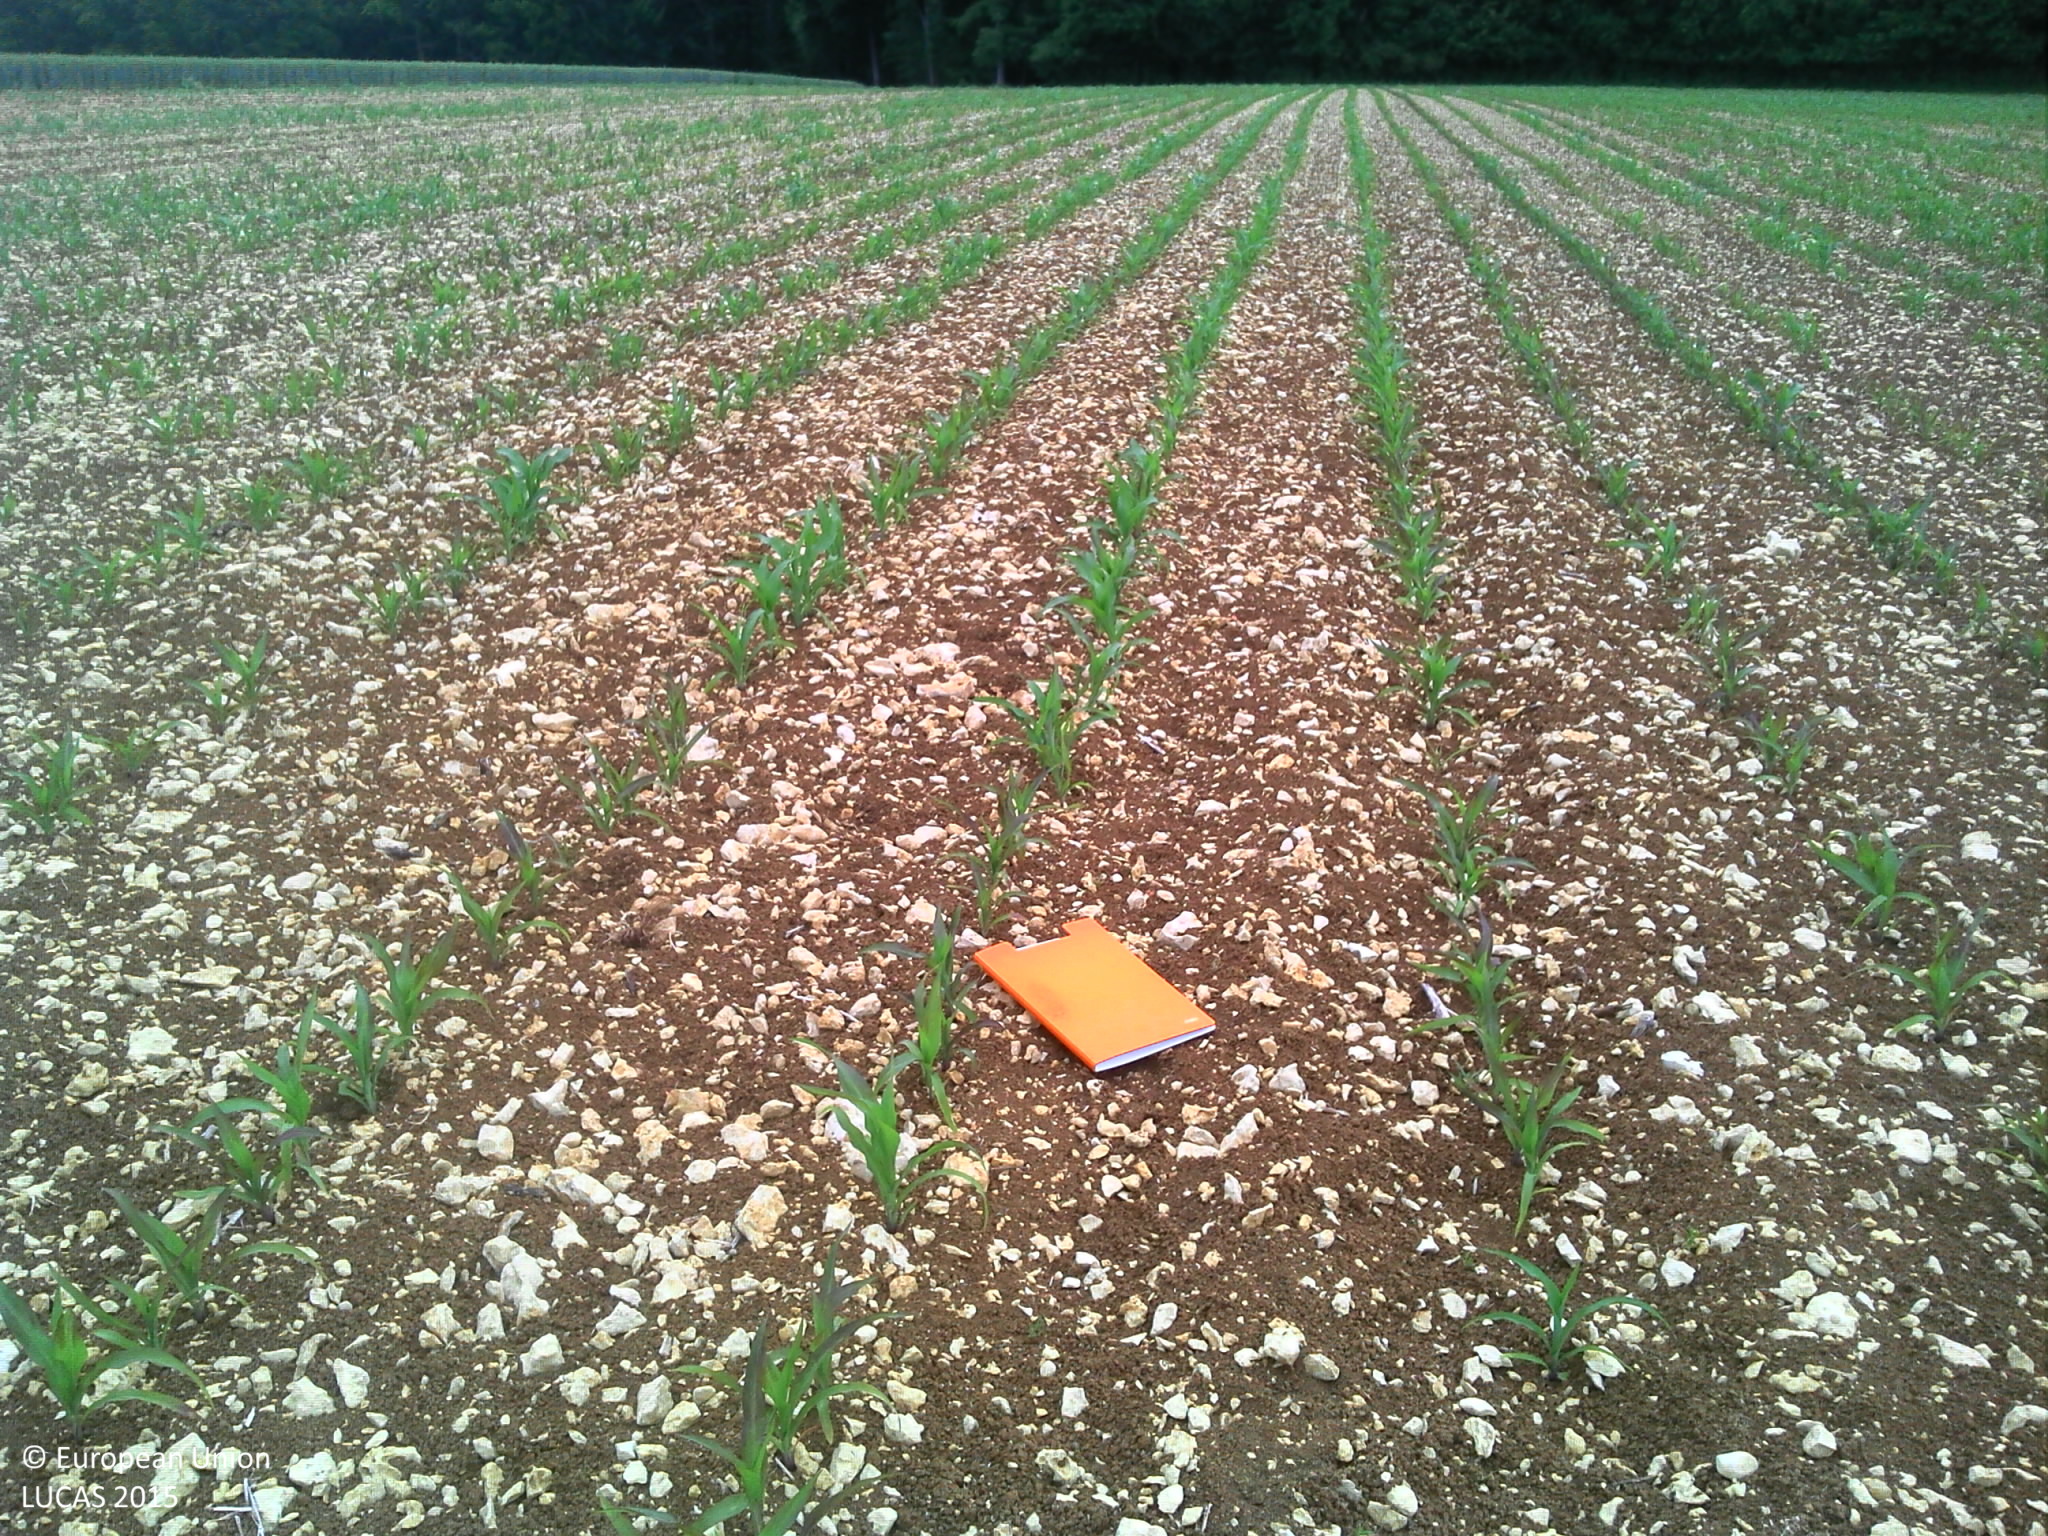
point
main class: Cropland
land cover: Maize
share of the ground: 10 - 25 %
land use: Agriculture (excluding fallow land and kitchen gardens)
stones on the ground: > 50 %
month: June
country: FR
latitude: 48.3430
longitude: 4.9660
